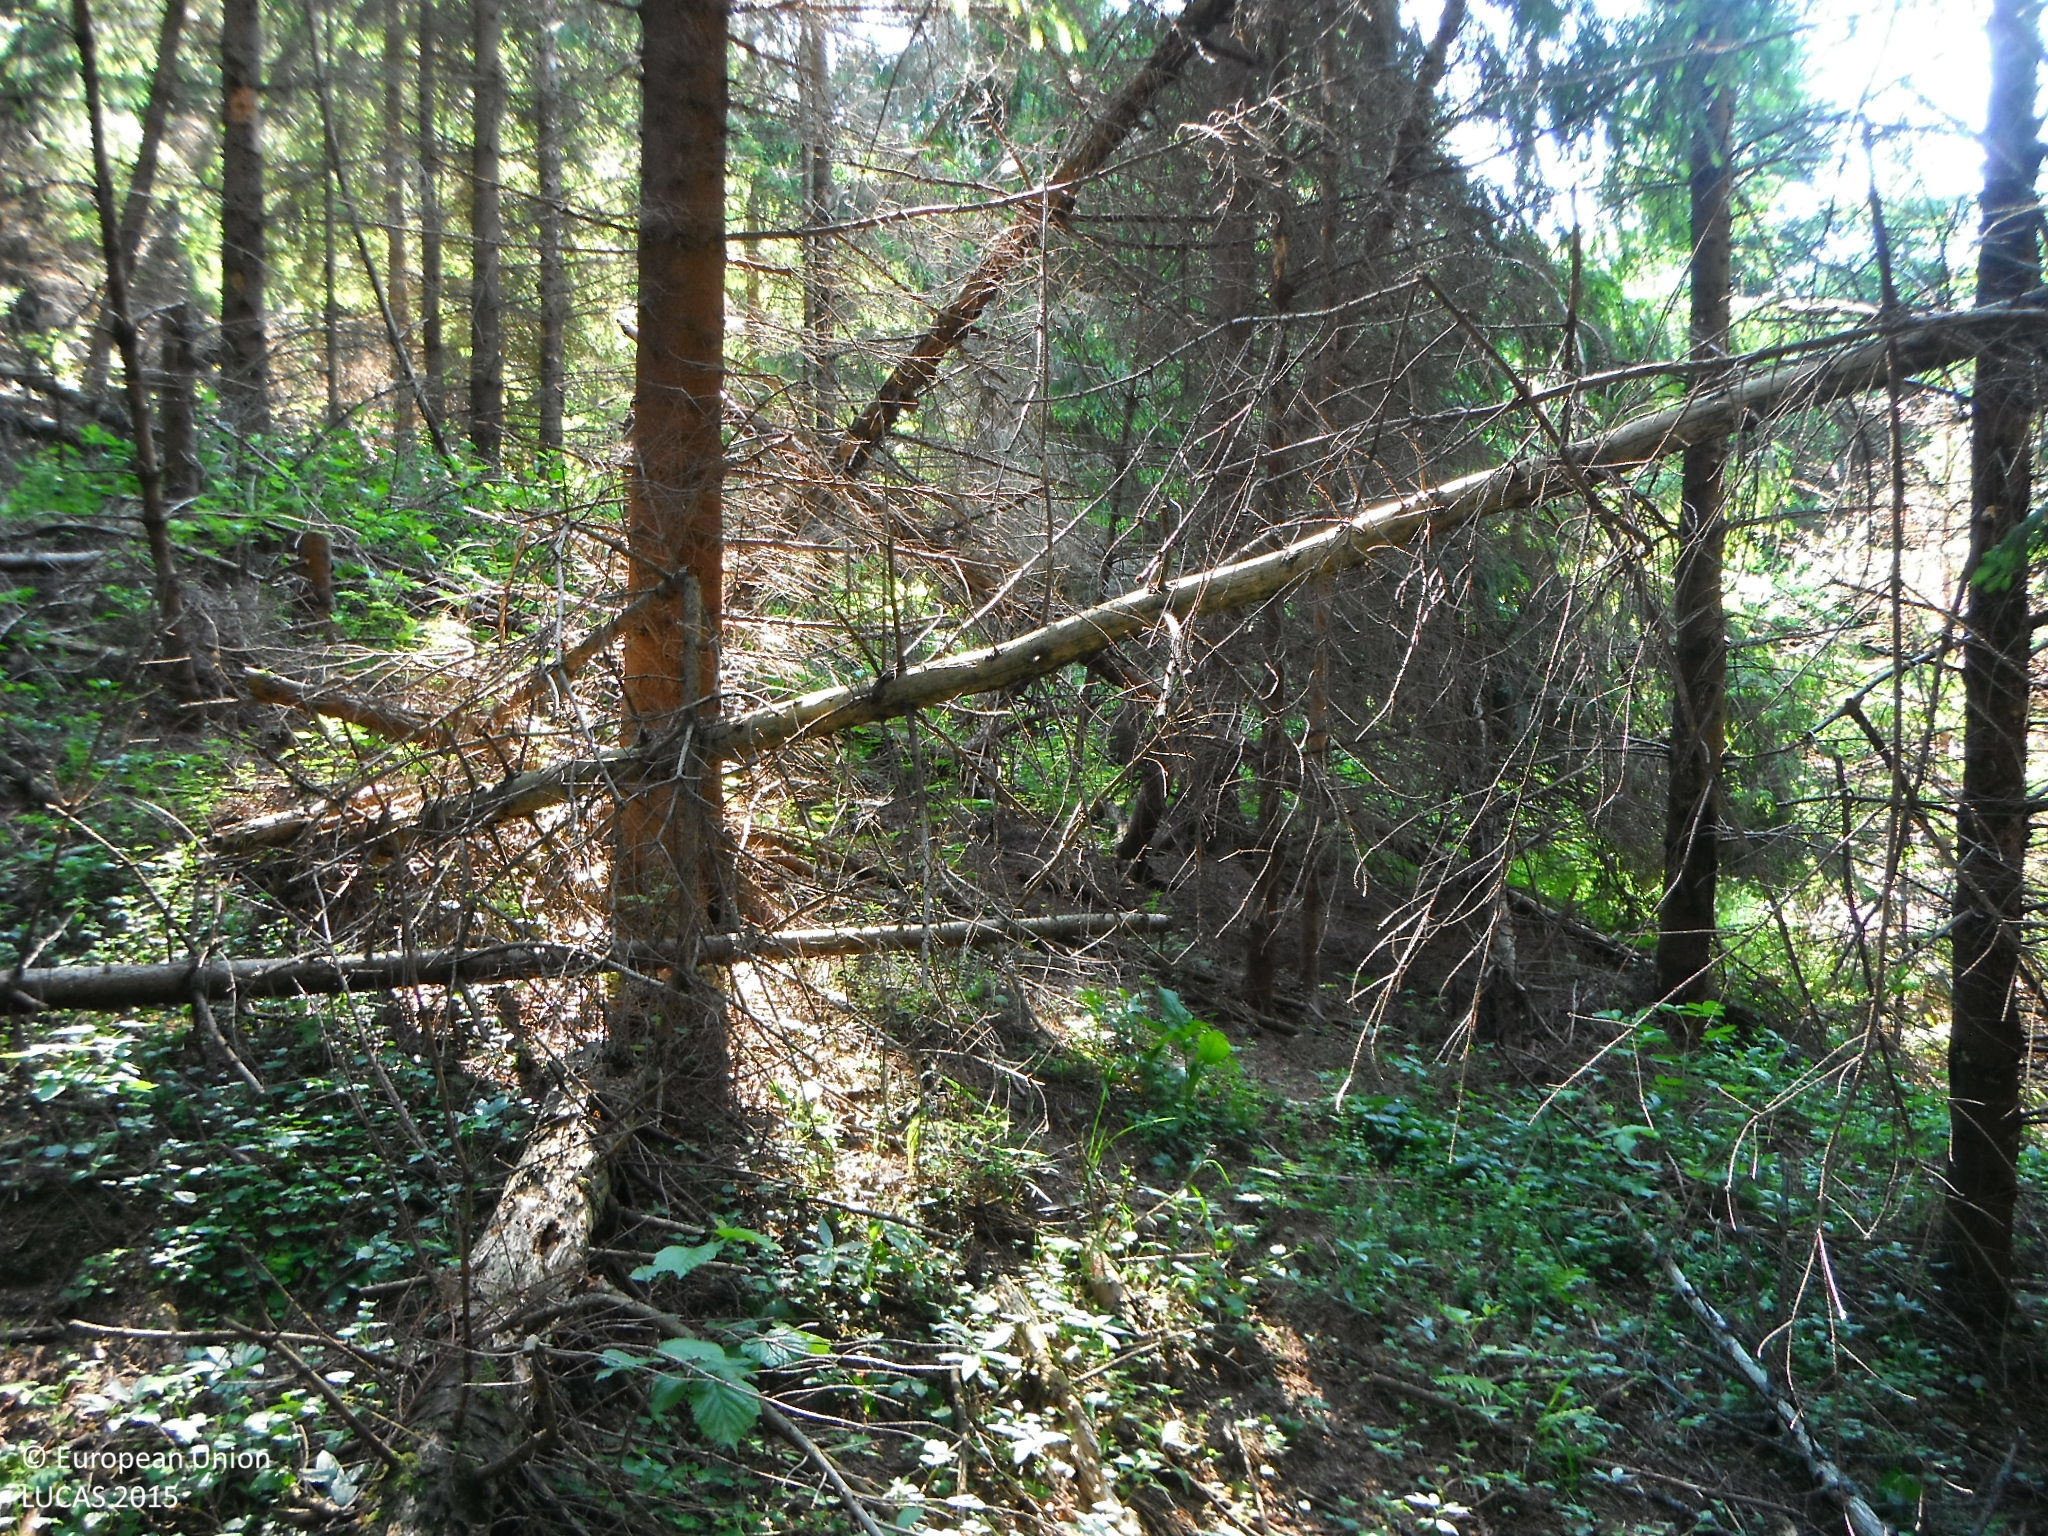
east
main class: Woodland
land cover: Spruce dominated coniferous woodland
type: alpine coniferous forest
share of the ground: > 75 %
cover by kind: coniferous forest trees 100 %
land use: Forestry
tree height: > 5 m
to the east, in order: Spruce dominated coniferous woodland
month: June
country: SK
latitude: 49.2551
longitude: 20.7701
